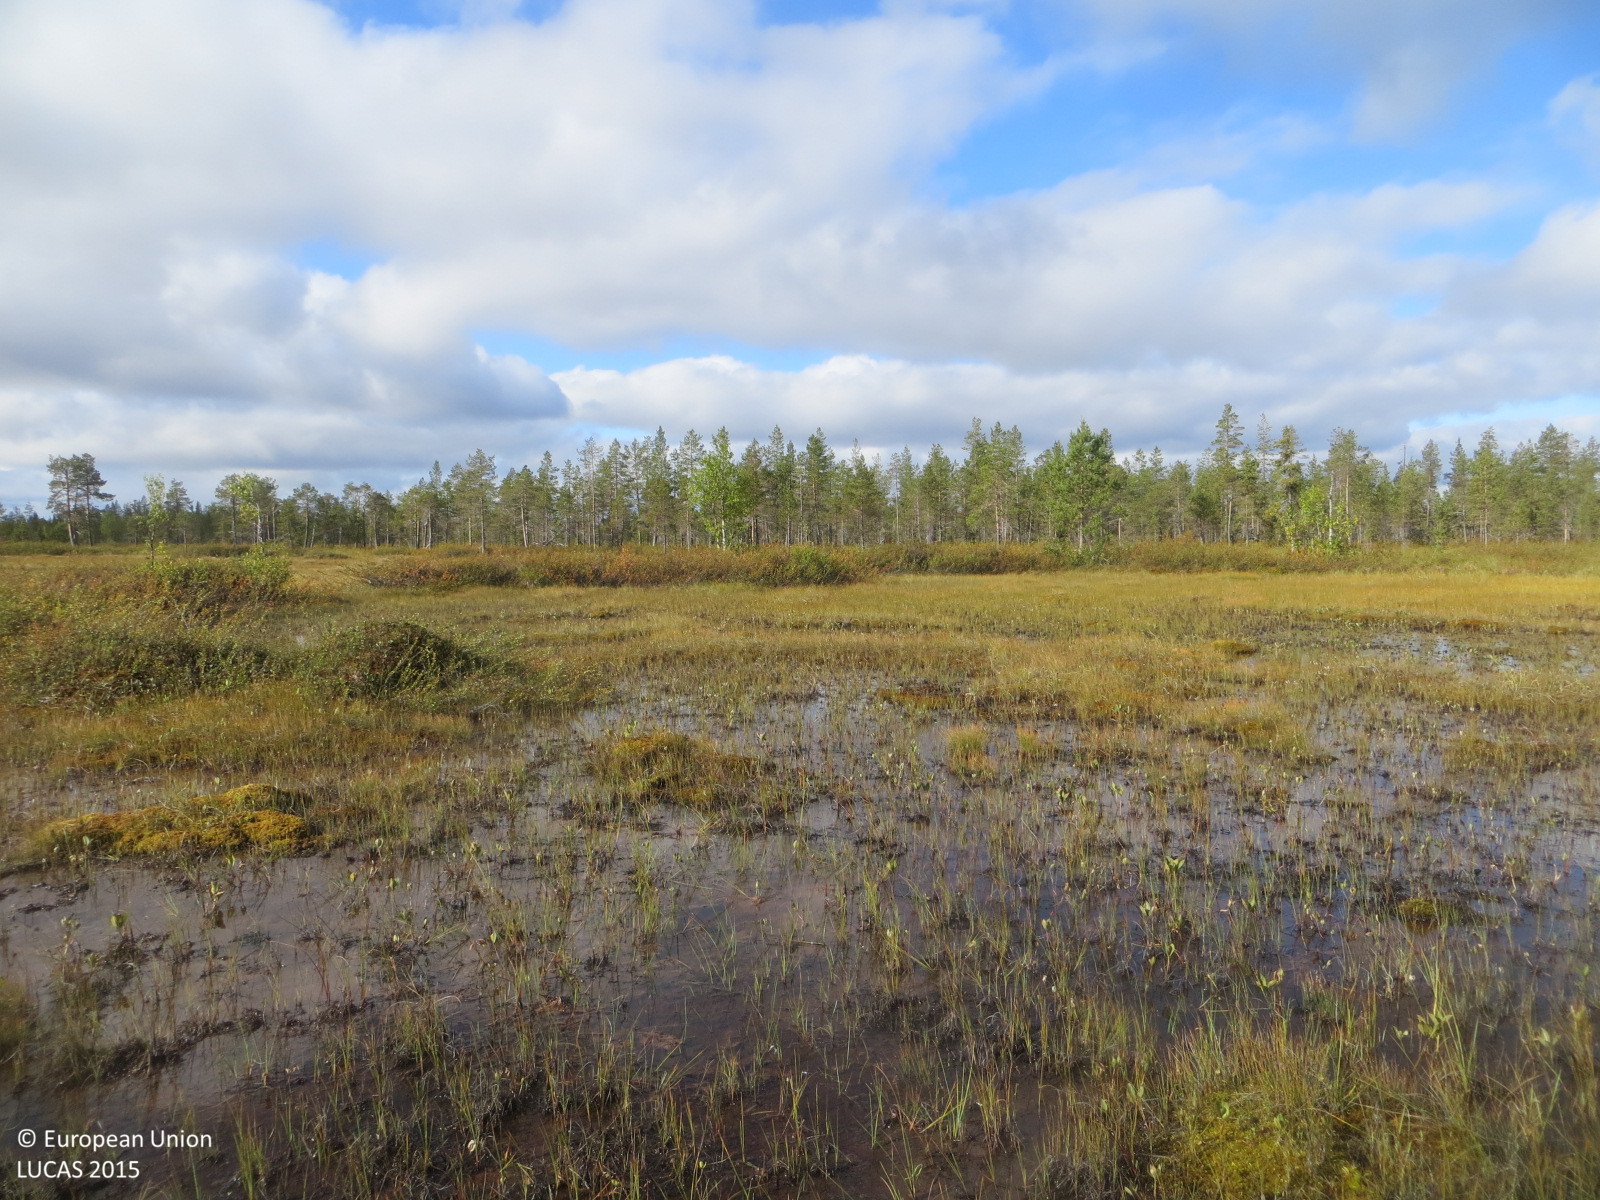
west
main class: Woodland
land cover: Pine dominated coniferous woodland
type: mire and swamp forests
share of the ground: 50 - 75 %
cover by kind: coniferous forest trees 50 %, shrubs 50 %
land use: Semi-natural and natural areas not in use
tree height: > 5 m
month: September
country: FI
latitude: 68.1527
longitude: 24.8355
